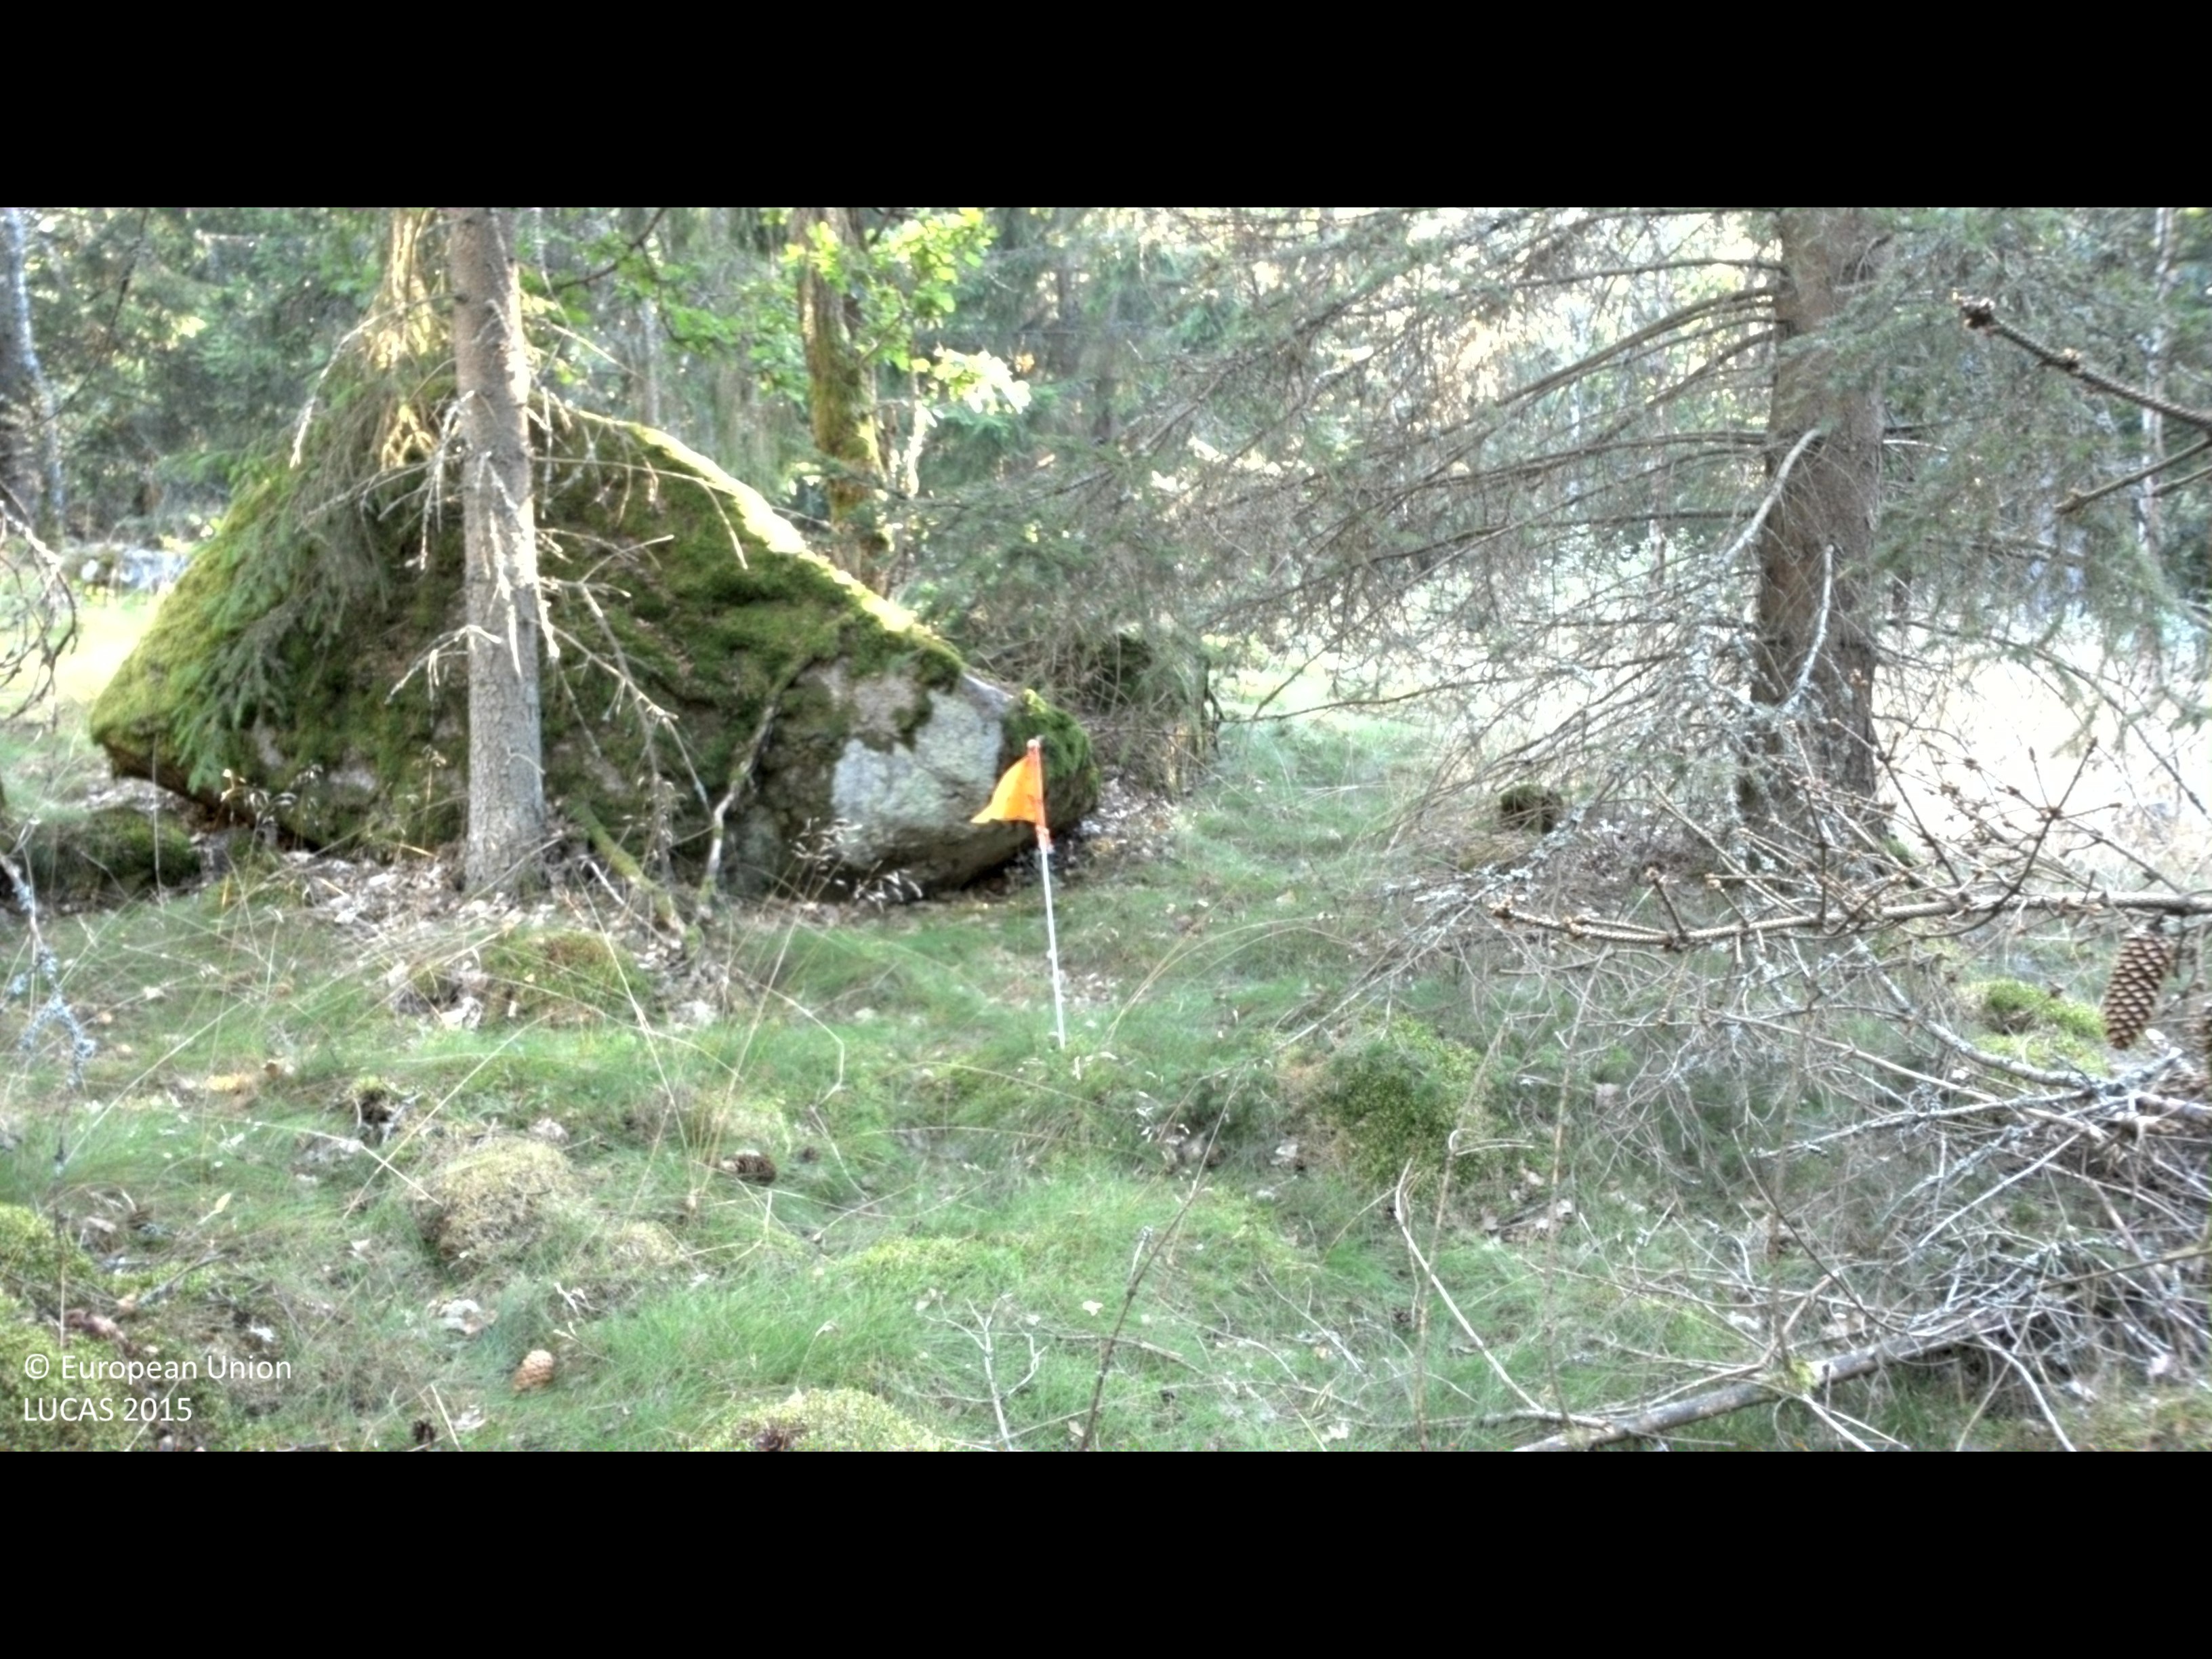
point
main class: Woodland
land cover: Spruce dominated coniferous woodland
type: boreal forest
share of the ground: 50 - 75 %
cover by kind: coniferous forest trees 55 %, herbaceous plants 20 %, lichens and mosses 20 %, broadleaved forest trees 5 %
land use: Forestry
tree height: > 5 m
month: August
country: SE
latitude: 56.2442
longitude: 15.2111
